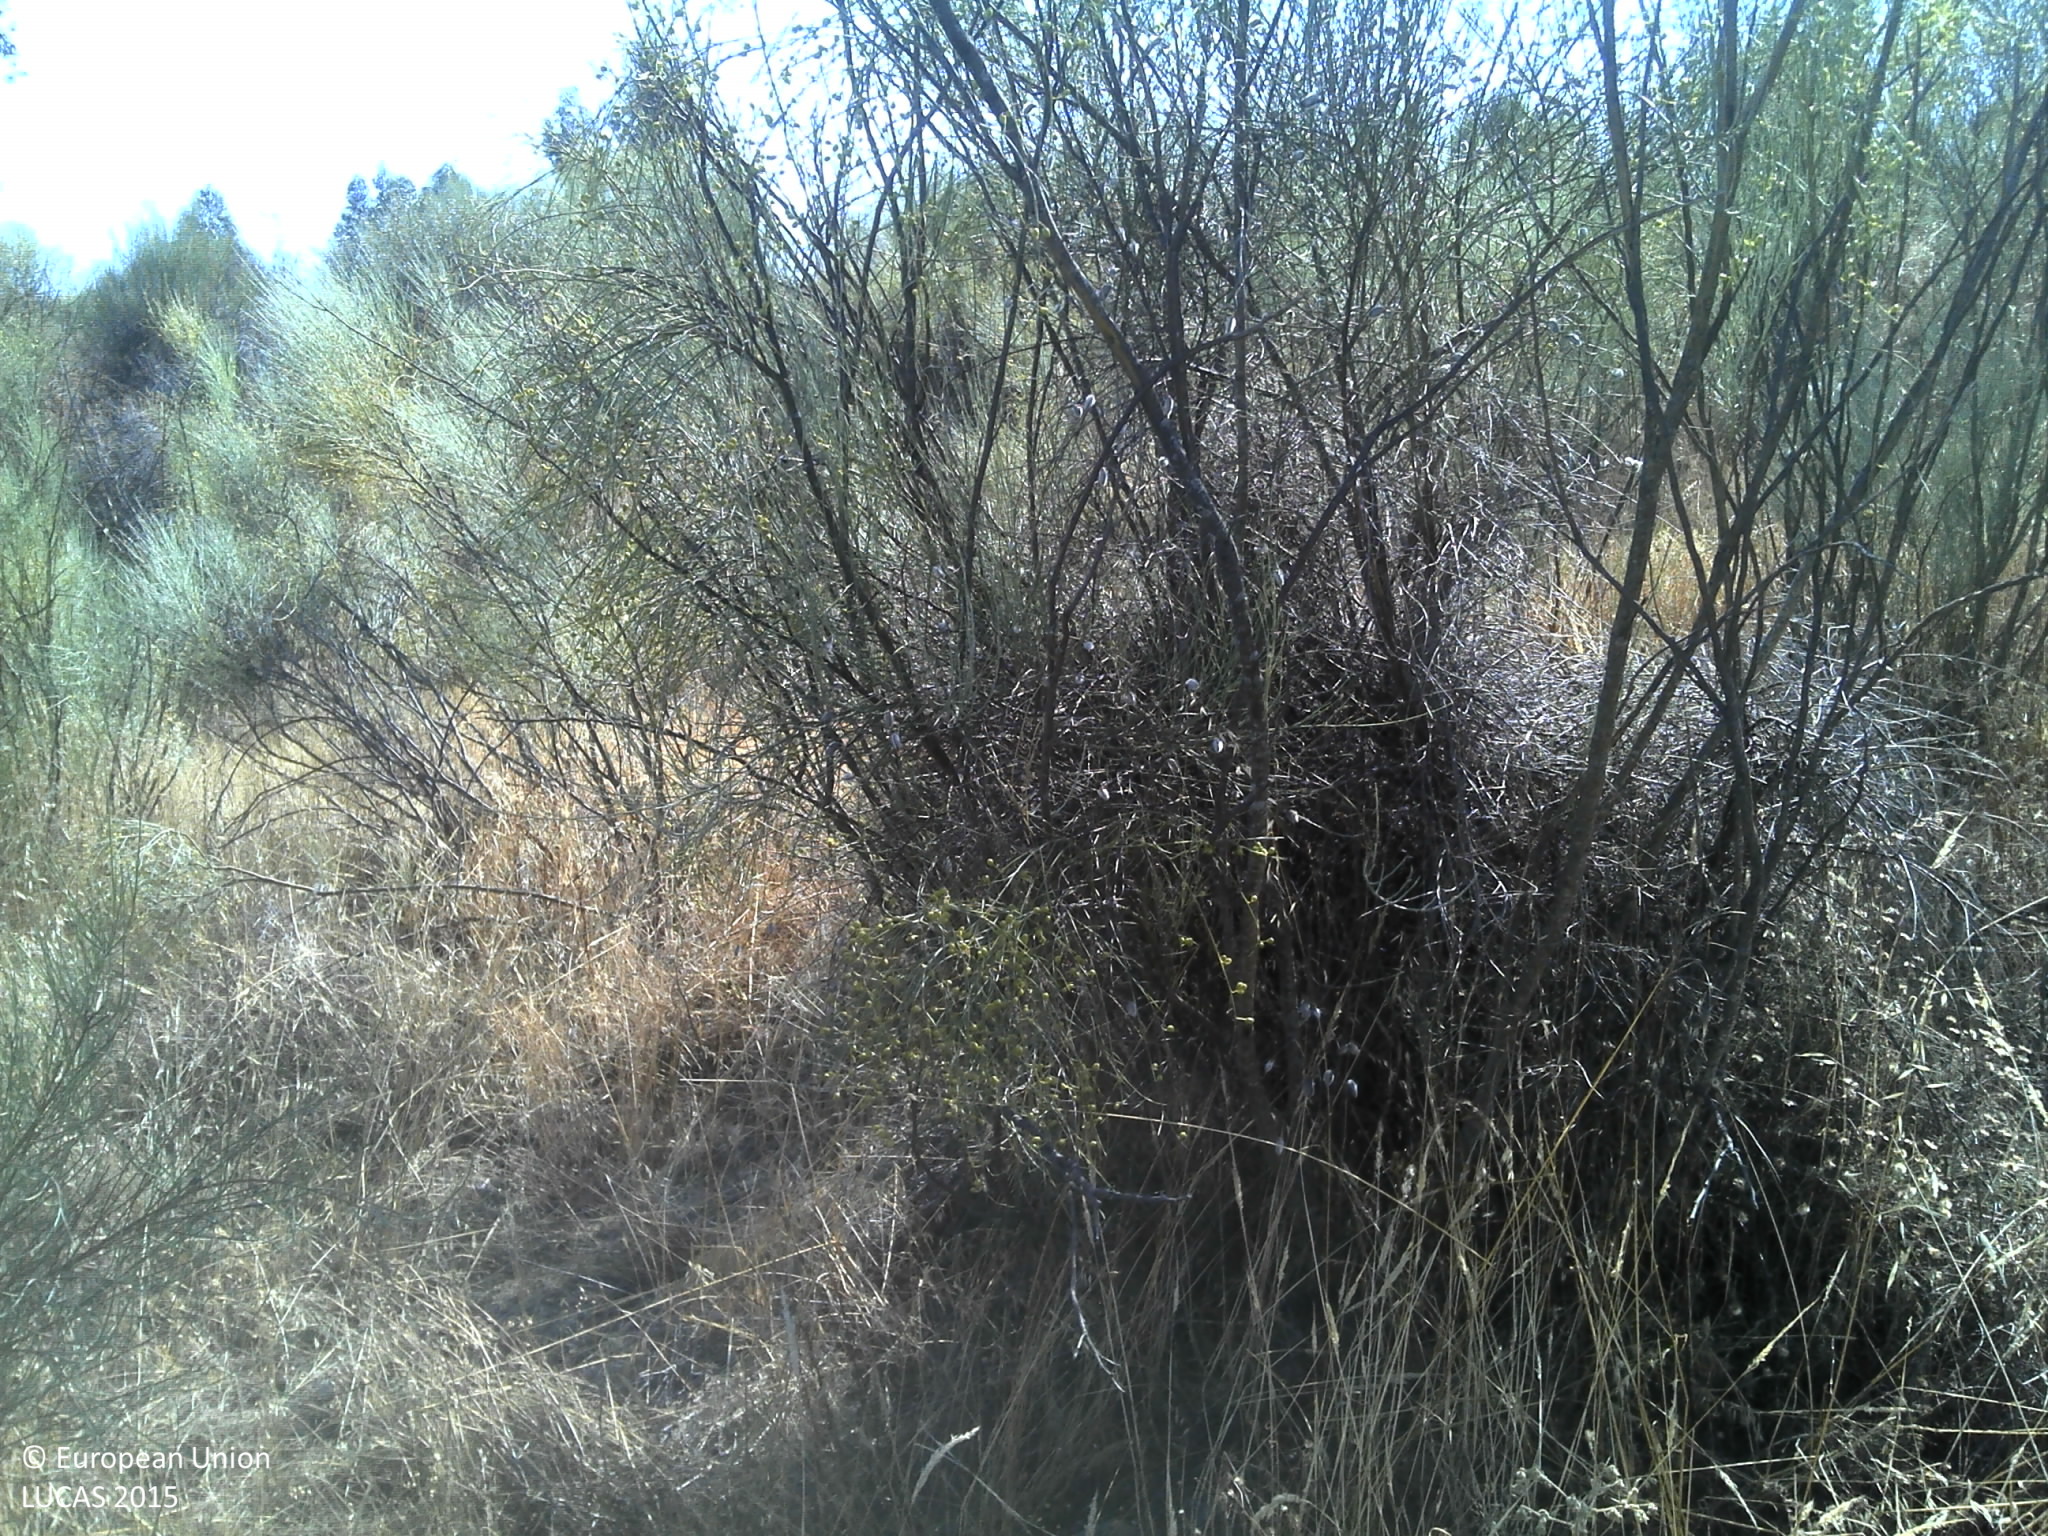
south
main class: Shrubland
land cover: Shrubland with sparse tree cover
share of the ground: 50 - 75 %
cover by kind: shrubs 50 %, herbaceous plants 25 %, unconsolidated bare surface 10 %, broadleaved forest trees 5 %
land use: Forestry
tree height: > 5 m
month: June
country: PT
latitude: 39.7940
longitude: -7.0567
